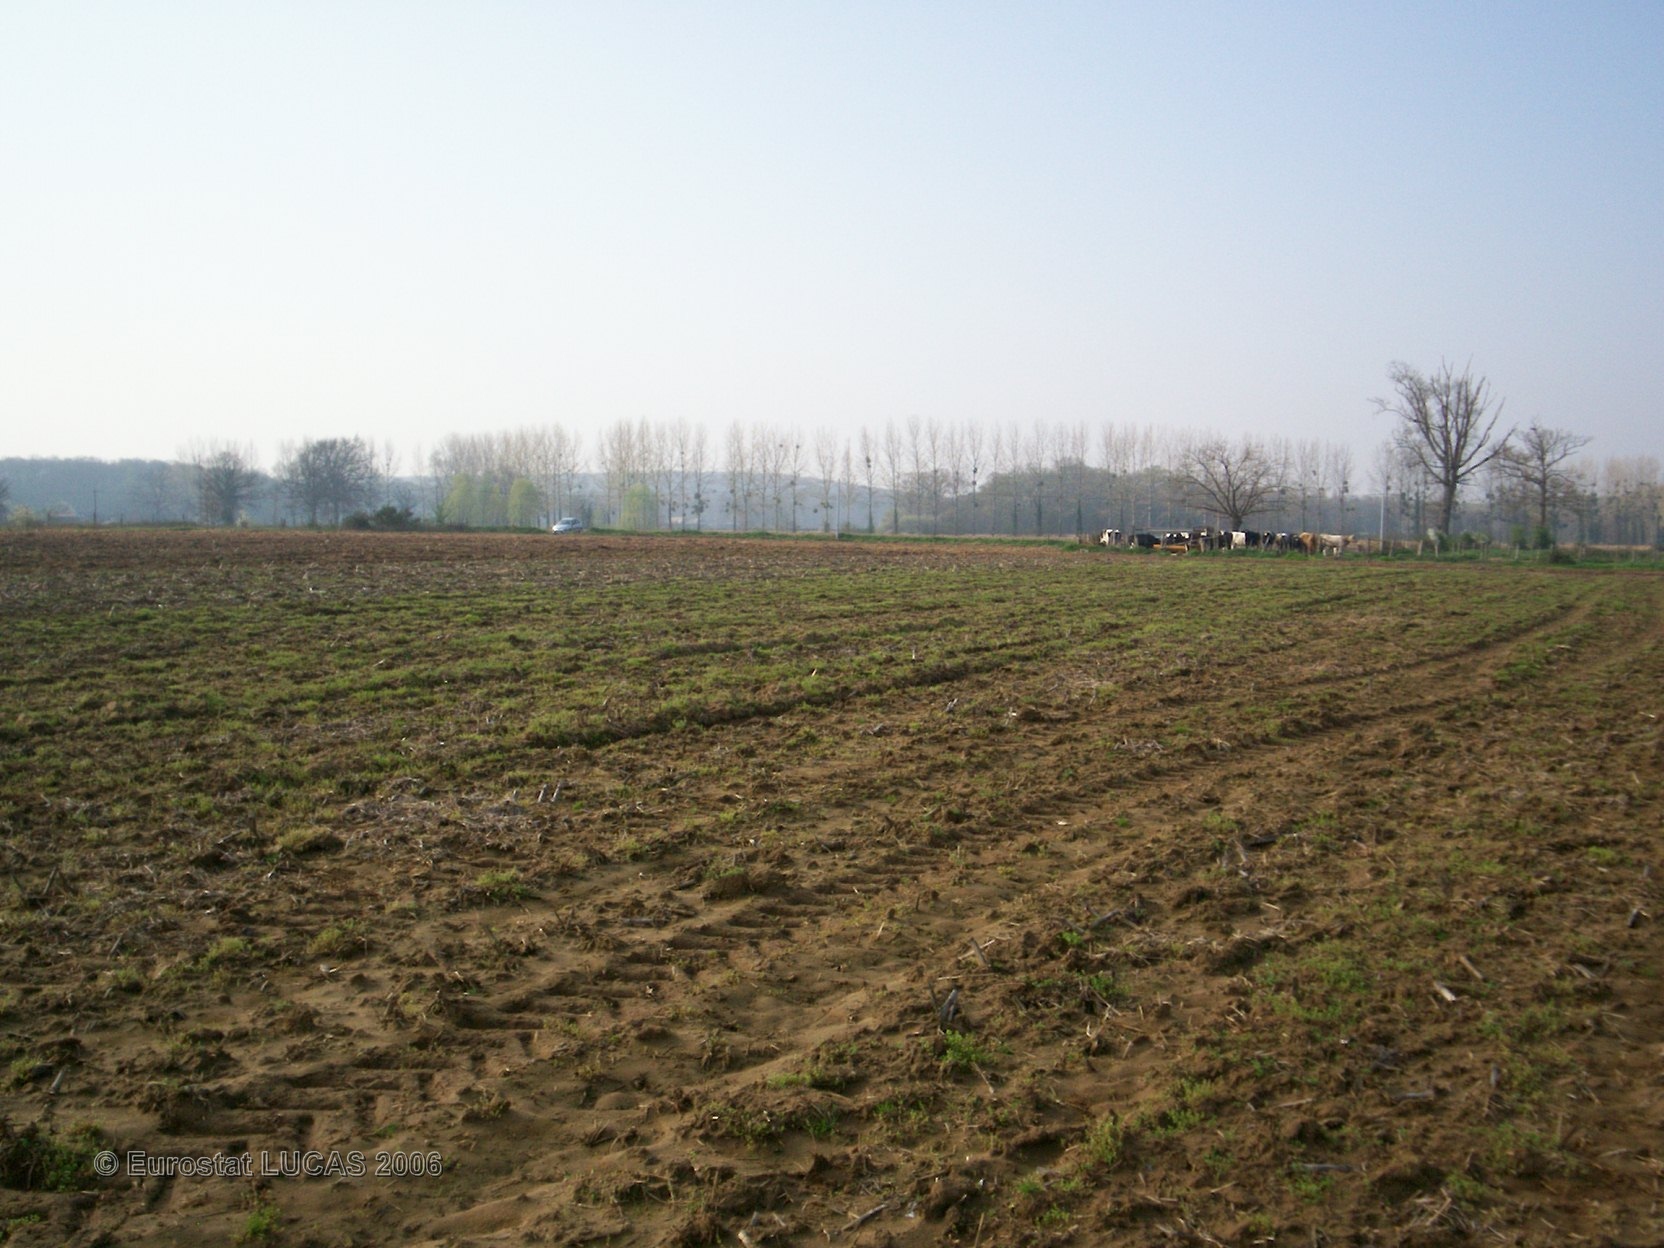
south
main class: Cropland
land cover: Maize
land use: Agriculture (excluding fallow land and kitchen gardens)
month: May
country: FR
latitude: 48.0736
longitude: 0.3789
